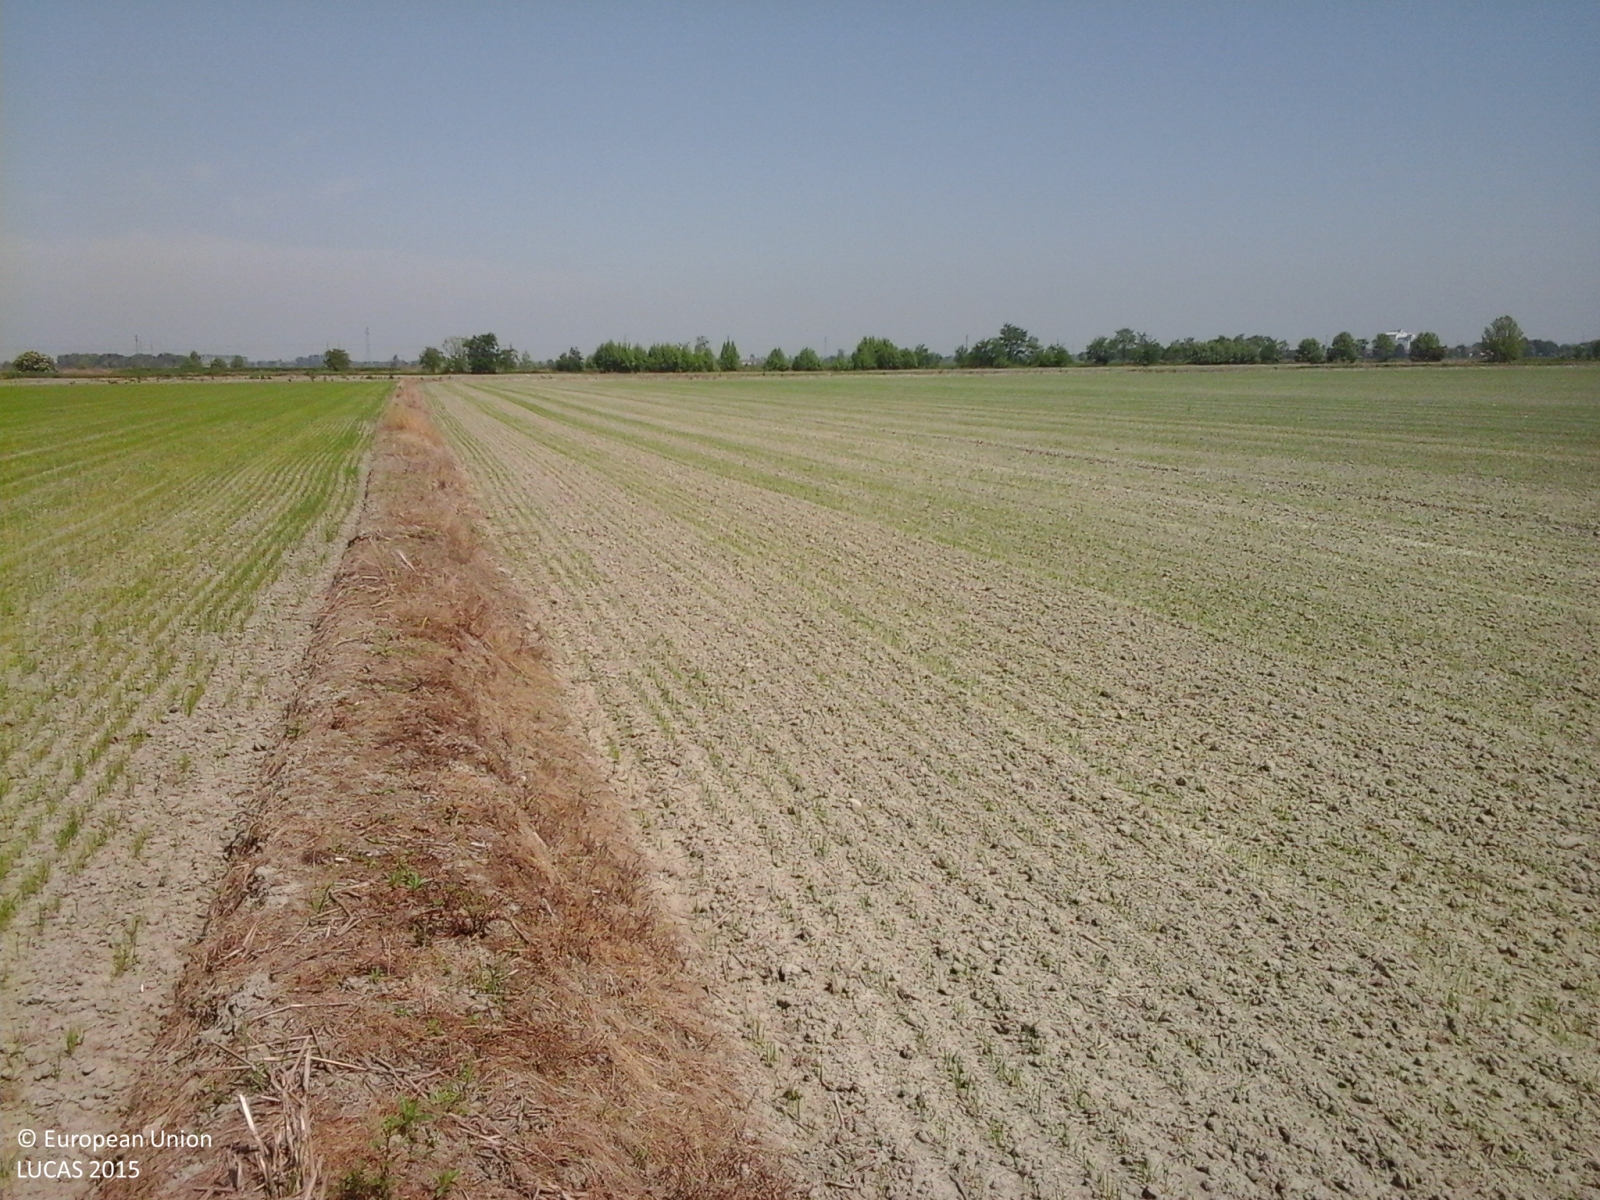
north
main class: Cropland
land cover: Rice
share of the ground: 10 - 25 %
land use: Agriculture (excluding fallow land and kitchen gardens)
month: May
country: IT
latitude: 45.1676
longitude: 8.3871
